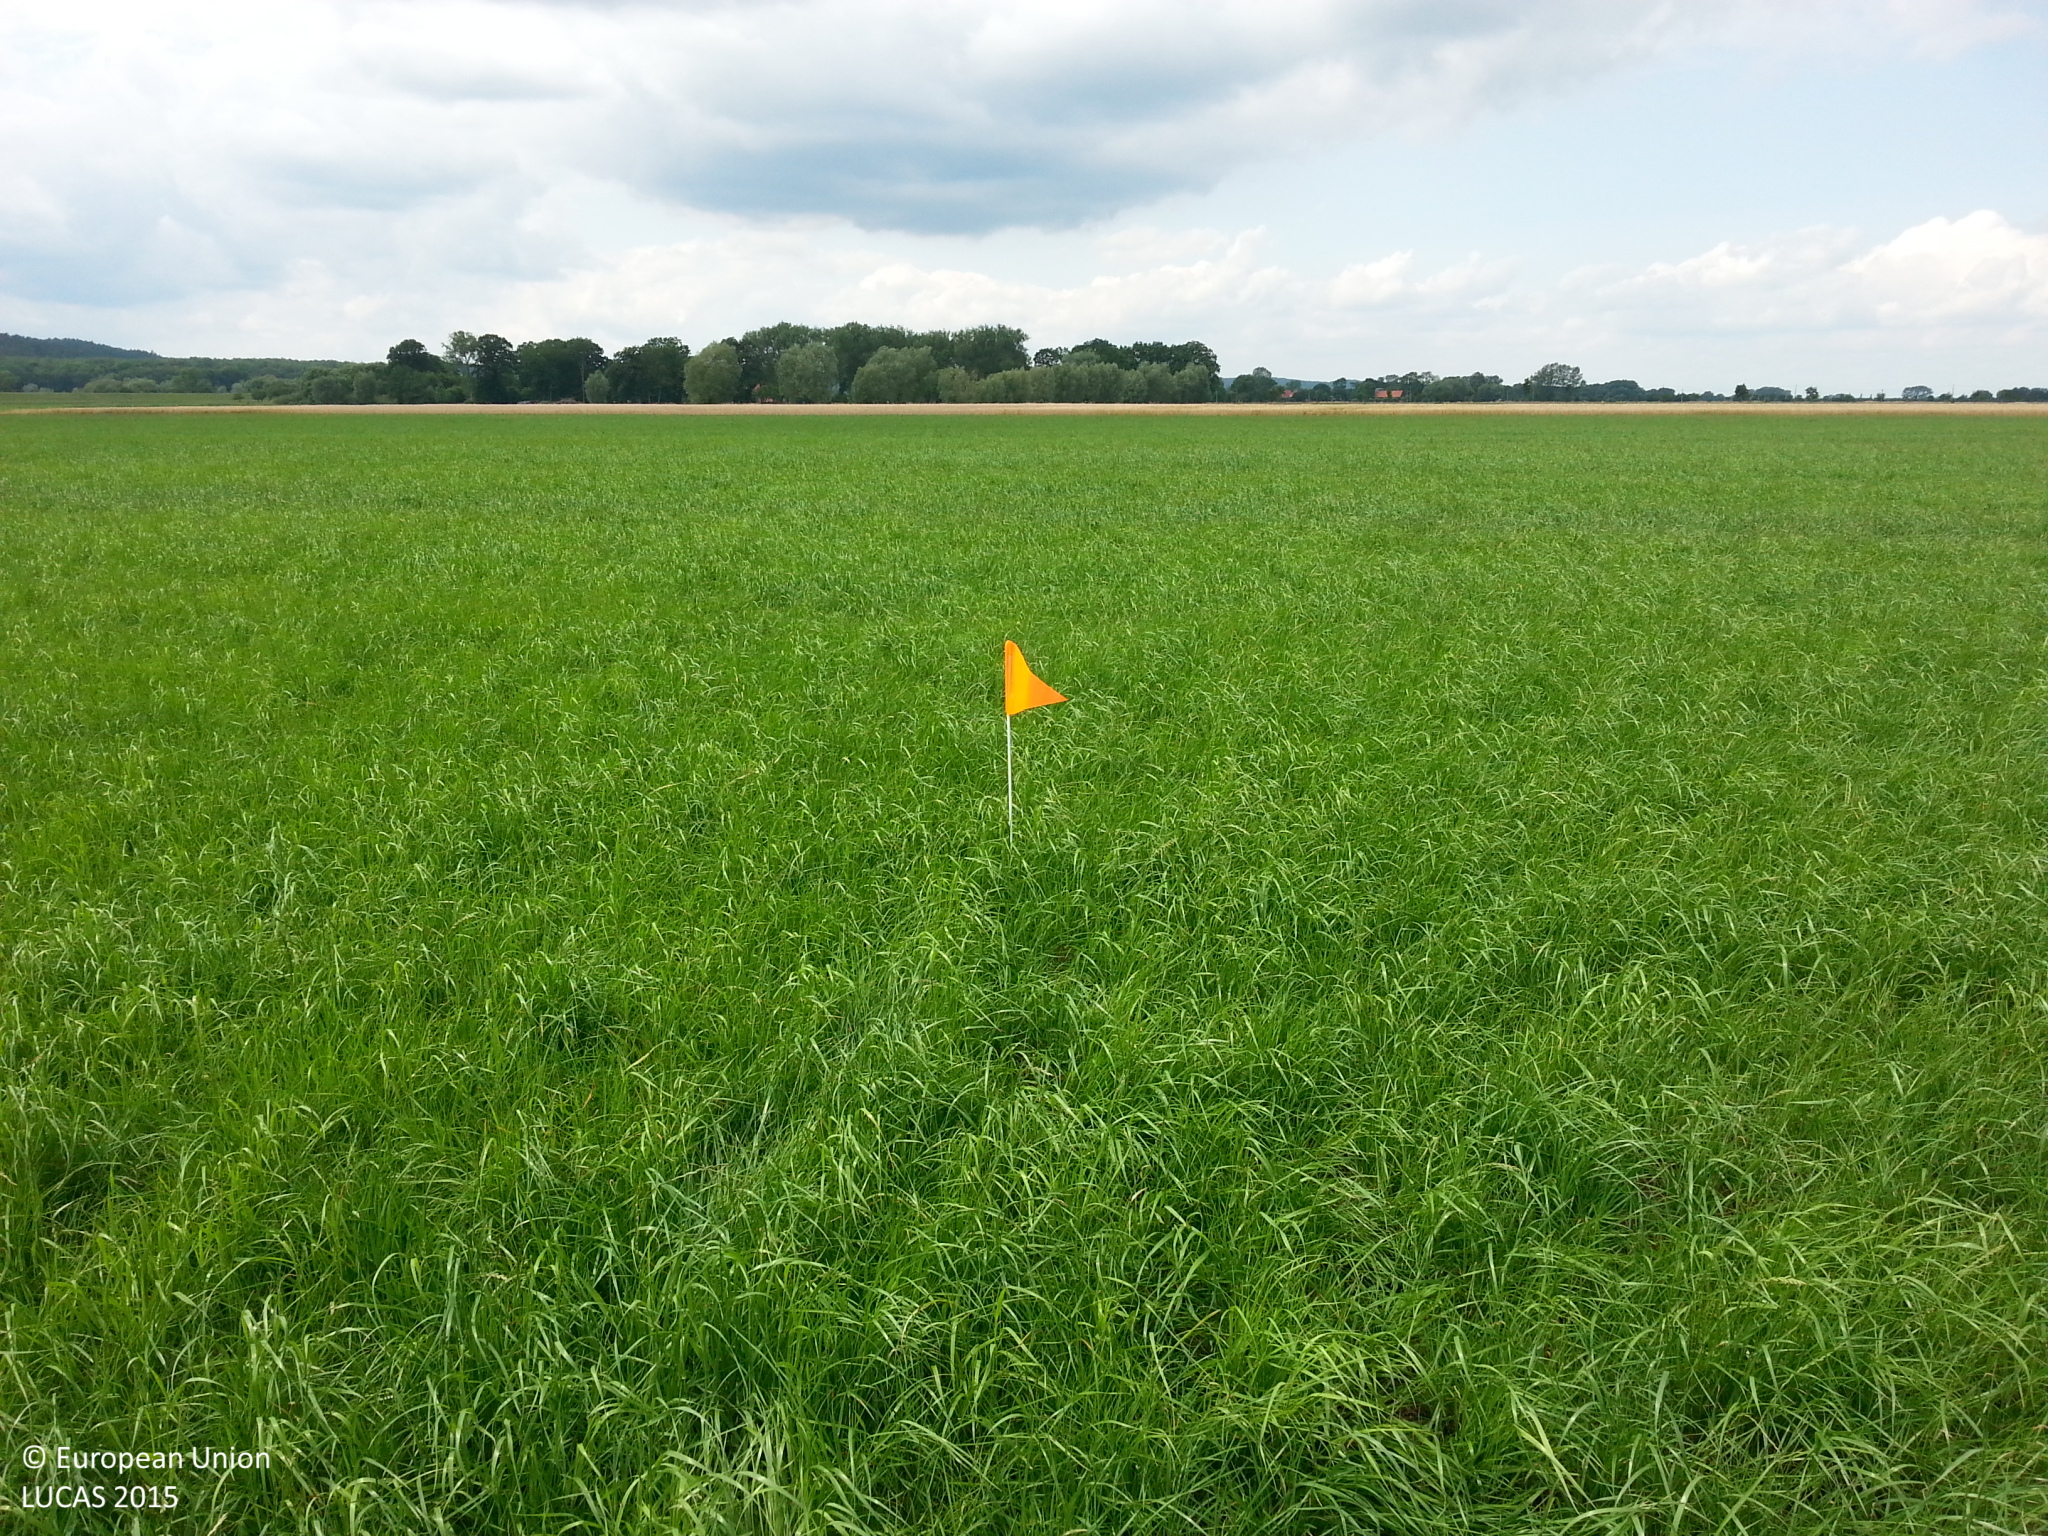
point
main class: Grassland
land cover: Grassland without tree/shrub cover
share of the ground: > 75 %
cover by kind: herbaceous plants 100 %
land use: Agriculture (excluding fallow land and kitchen gardens)
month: July
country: DE
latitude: 53.1818
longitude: 11.0320
